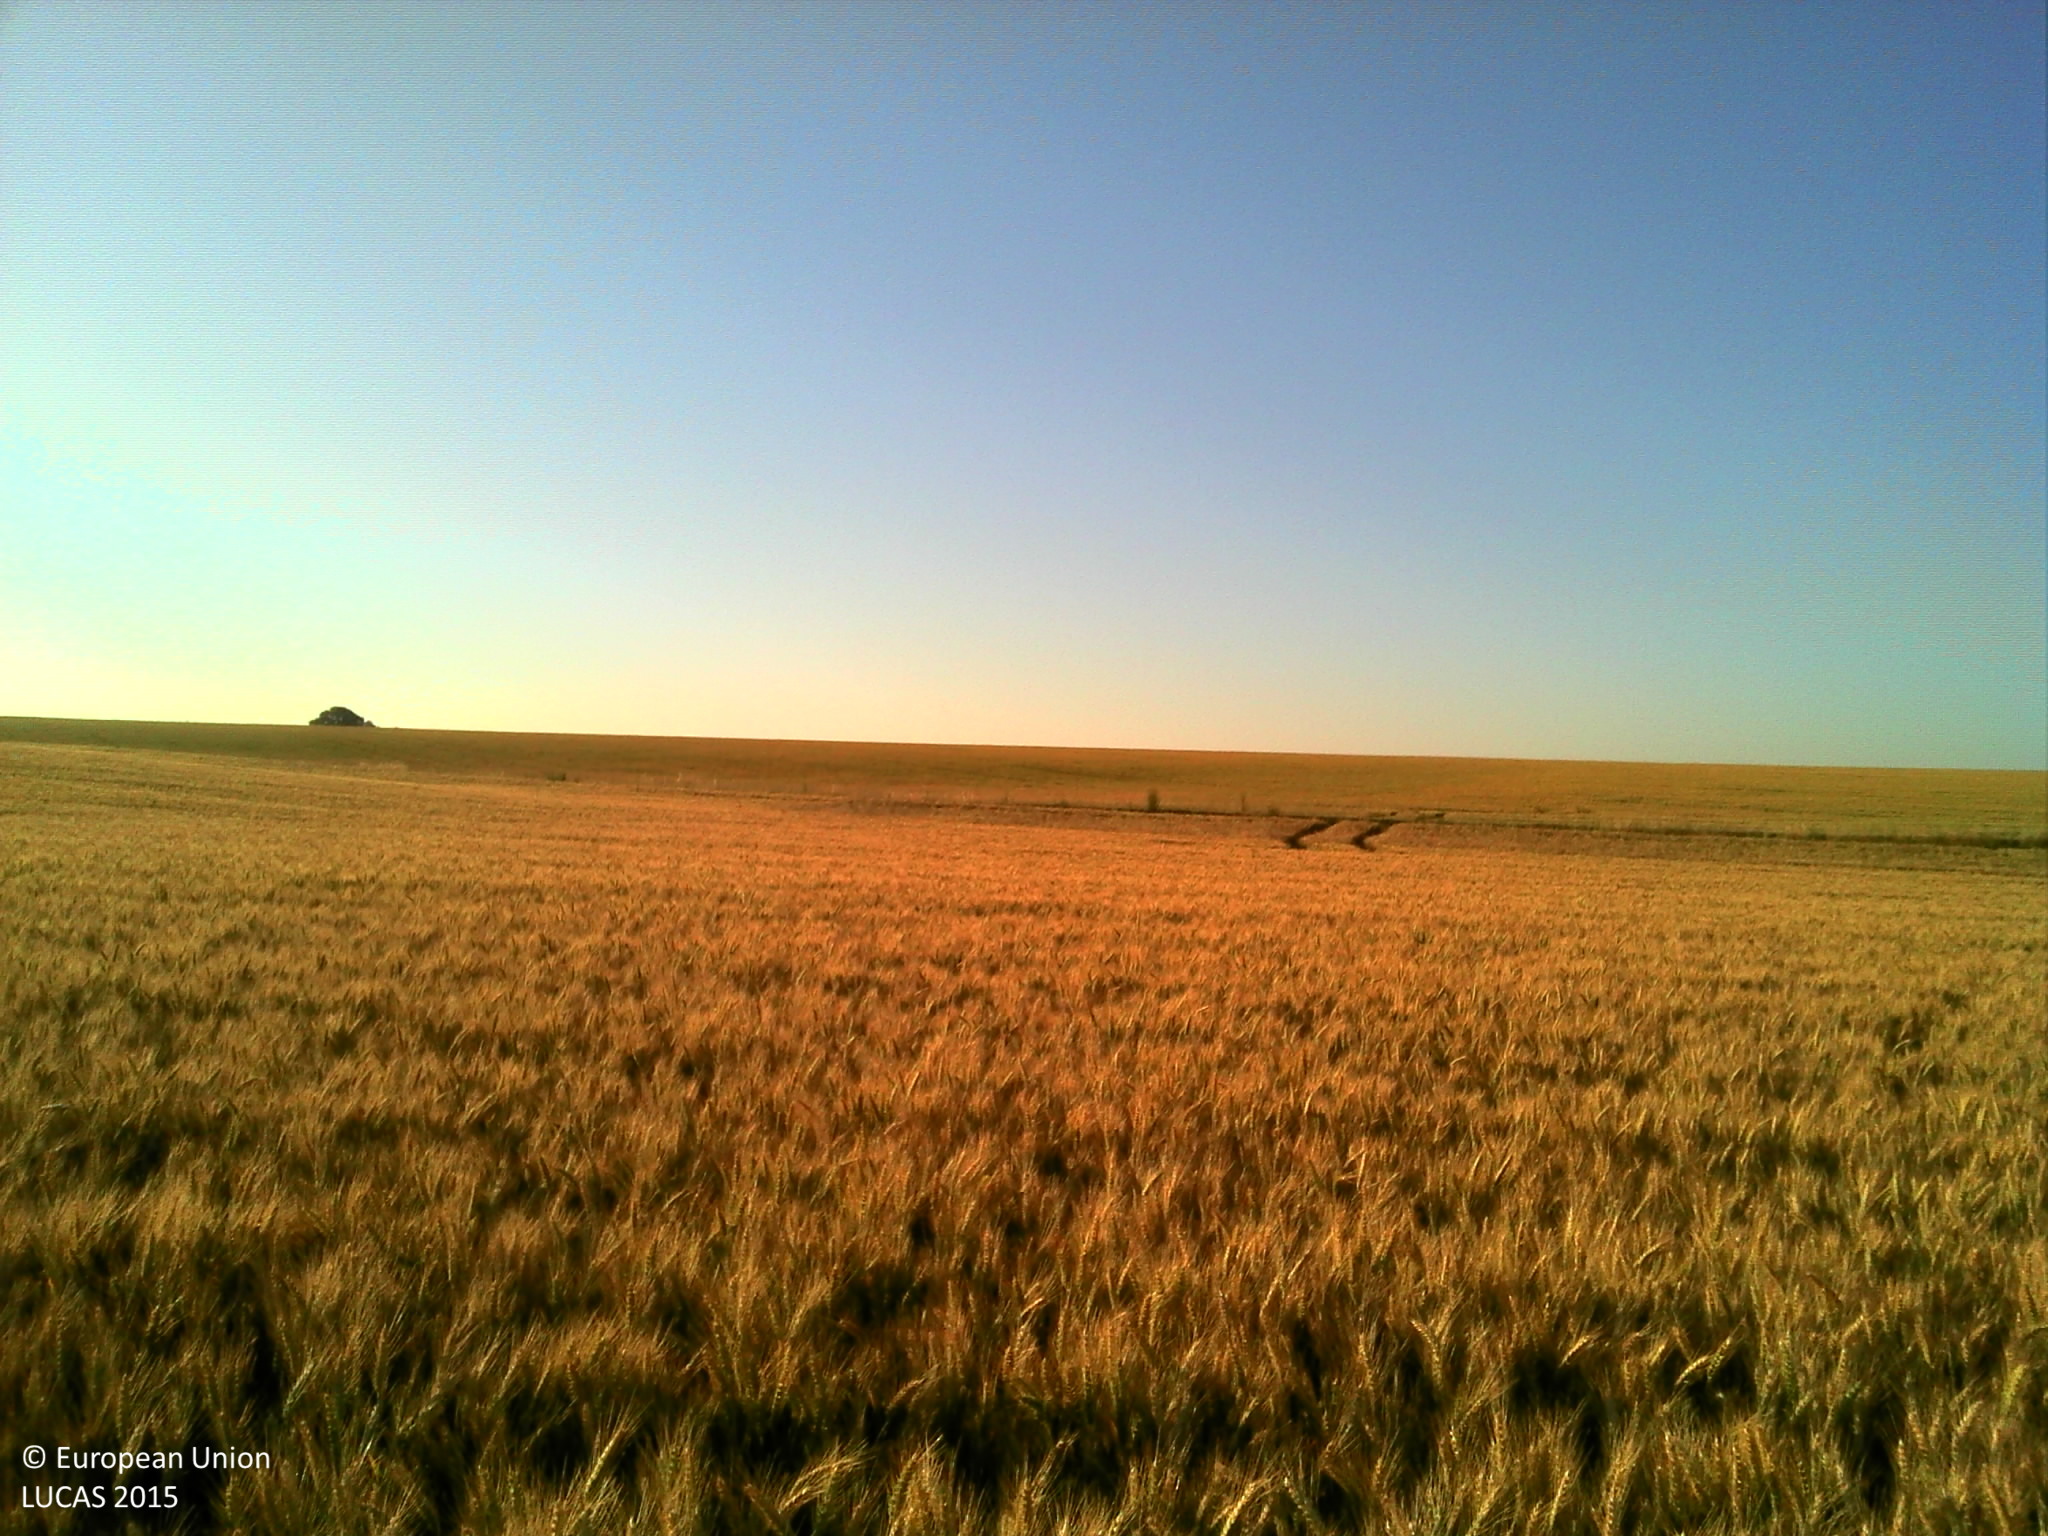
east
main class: Cropland
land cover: Common wheat
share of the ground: > 75 %
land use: Agriculture (excluding fallow land and kitchen gardens)
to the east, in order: Common wheat; Grass margins; Tracks; Grass margins; Common wheat
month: June
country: FR
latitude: 49.4277
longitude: 2.4459
